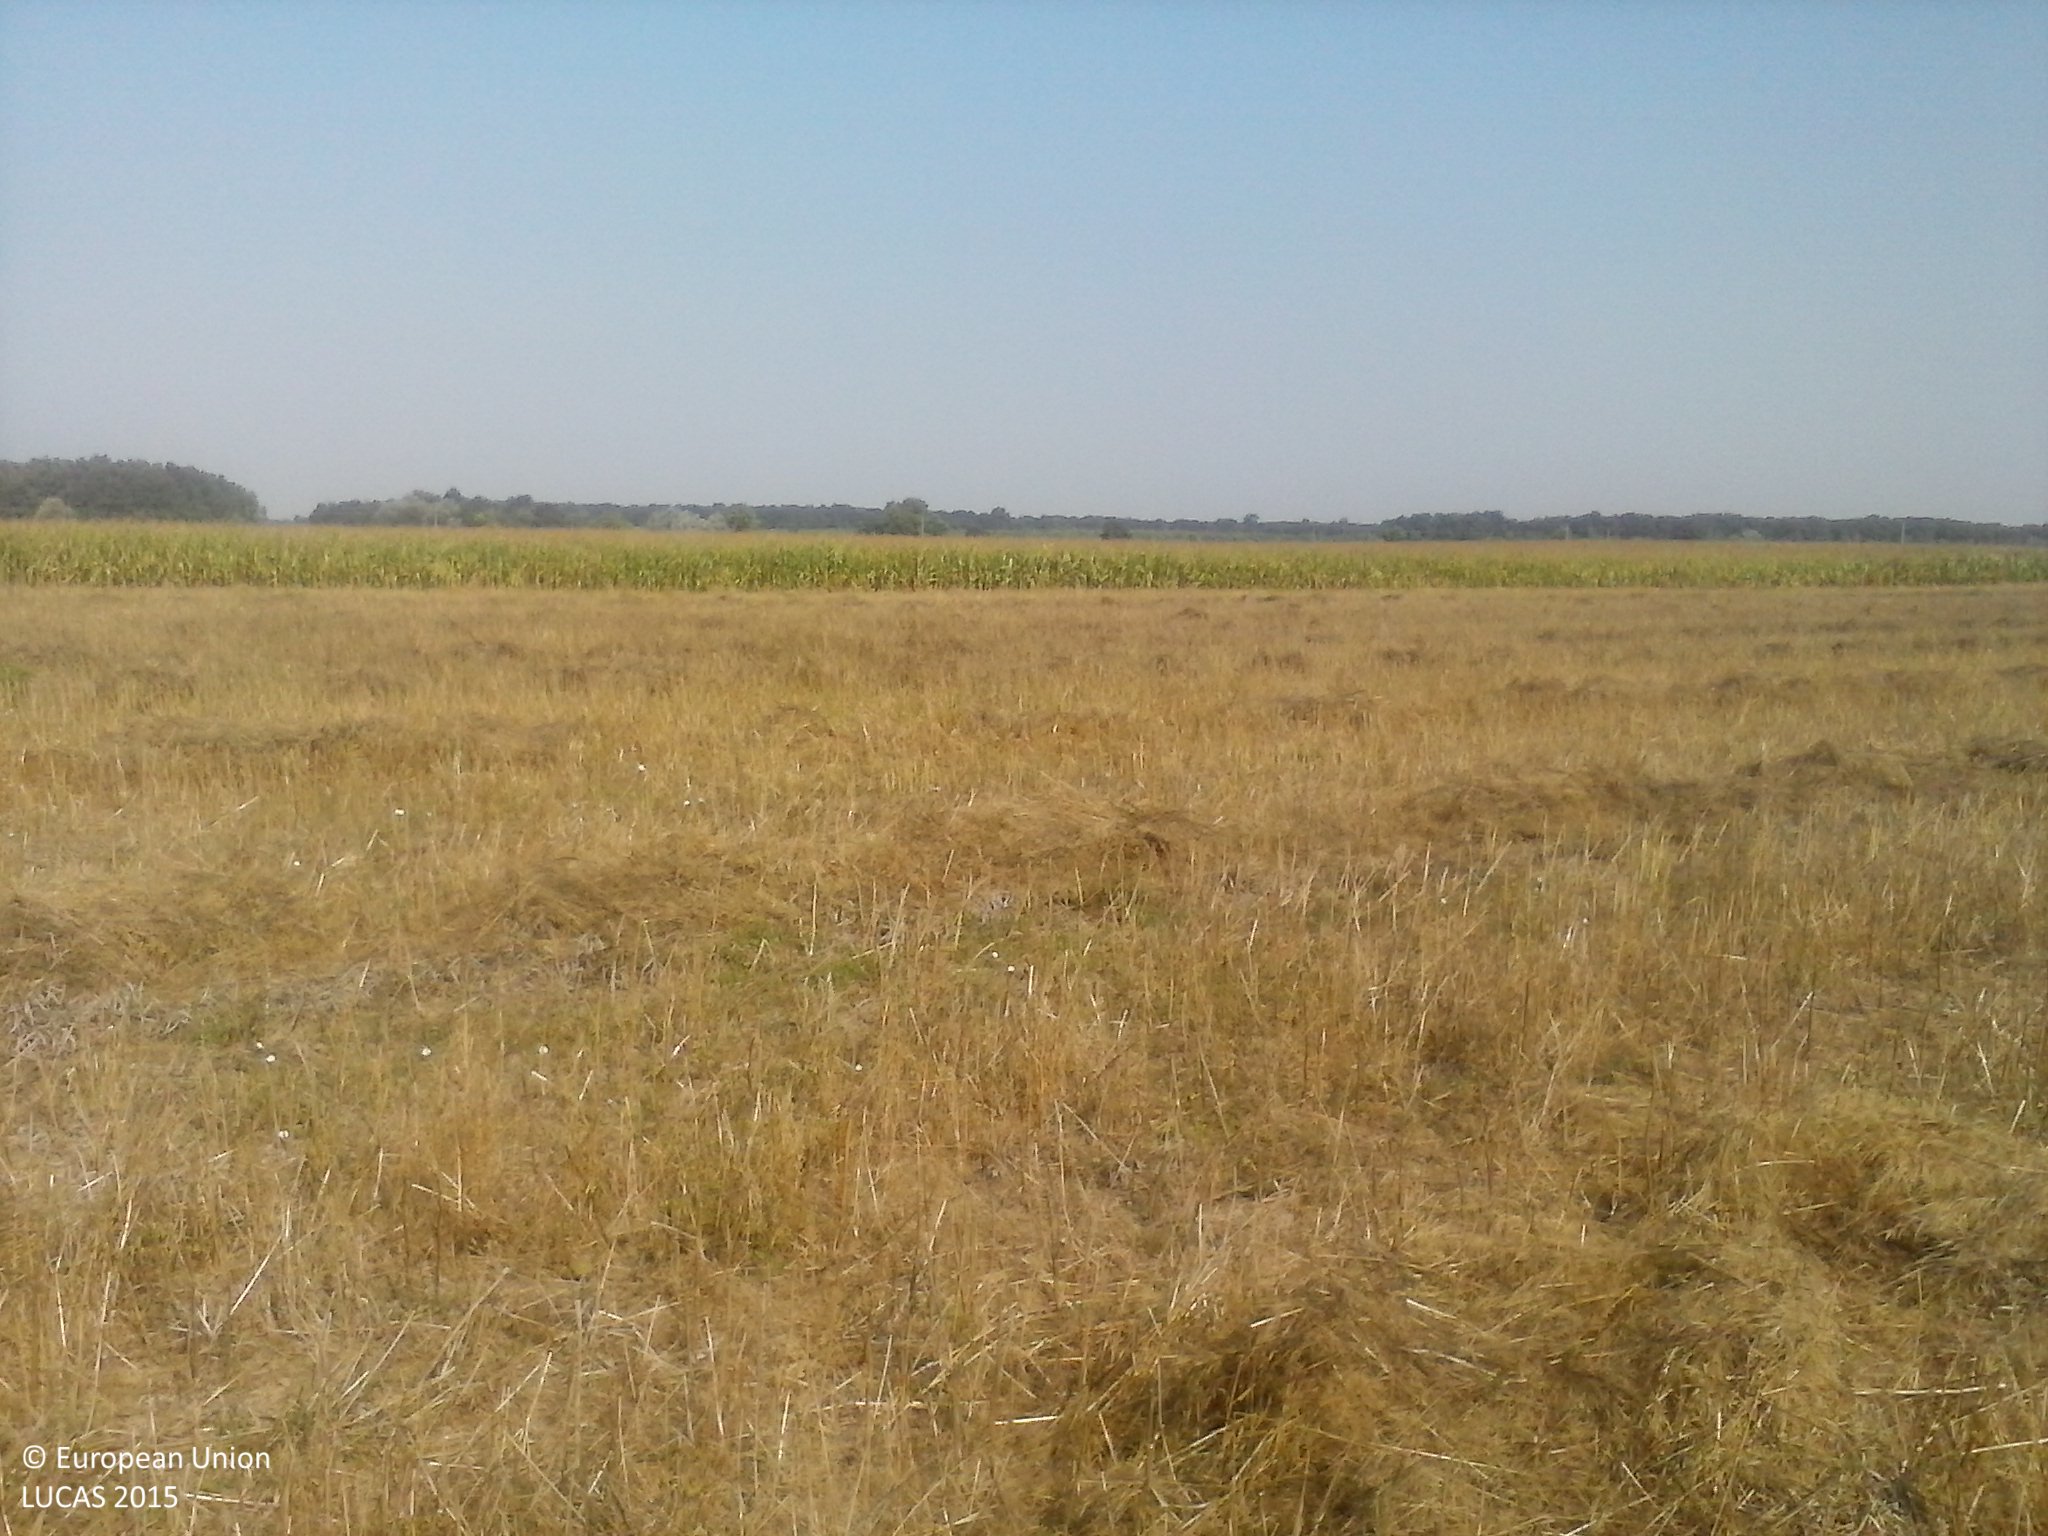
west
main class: Cropland
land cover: Rape and turnip rape
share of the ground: 25 - 50 %
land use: Agriculture (excluding fallow land and kitchen gardens)
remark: Harvested field
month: August
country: HU
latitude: 45.8916
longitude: 17.9565
